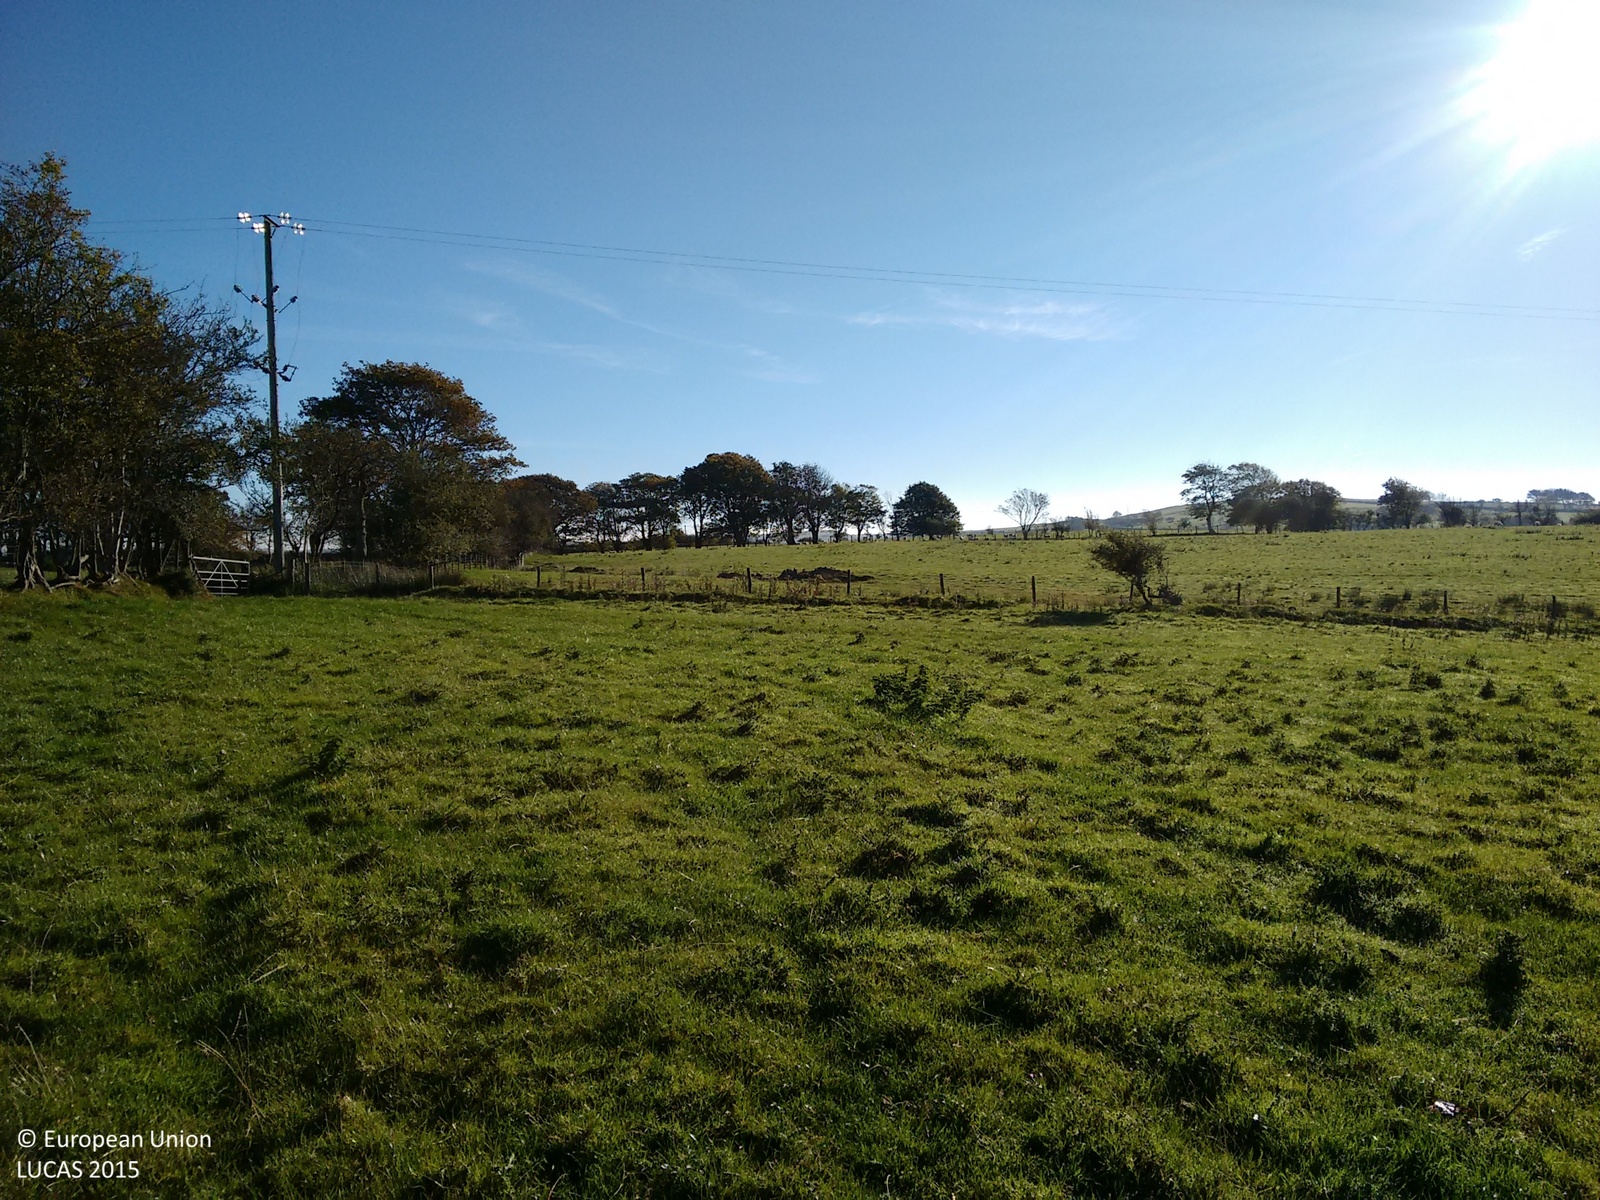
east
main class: Grassland
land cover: Grassland without tree/shrub cover
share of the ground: > 75 %
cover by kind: herbaceous plants 100 %
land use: Agriculture (excluding fallow land and kitchen gardens)
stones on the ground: < 10 %
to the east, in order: Grassland without tree/shrub cover; Fences; Electric lines; Grassland without tree/shrub cover; Abandoned hedges; Fences; Grassland without tree/shrub cover; Lines of trees; Fences; Grass margins; Paved roads, cycling and walking lanes; Grass margins; Fences; Electric lines; Lines of trees; Grassland without tree/shrub cover
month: October
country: GB
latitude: 52.3848
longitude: -3.9784
